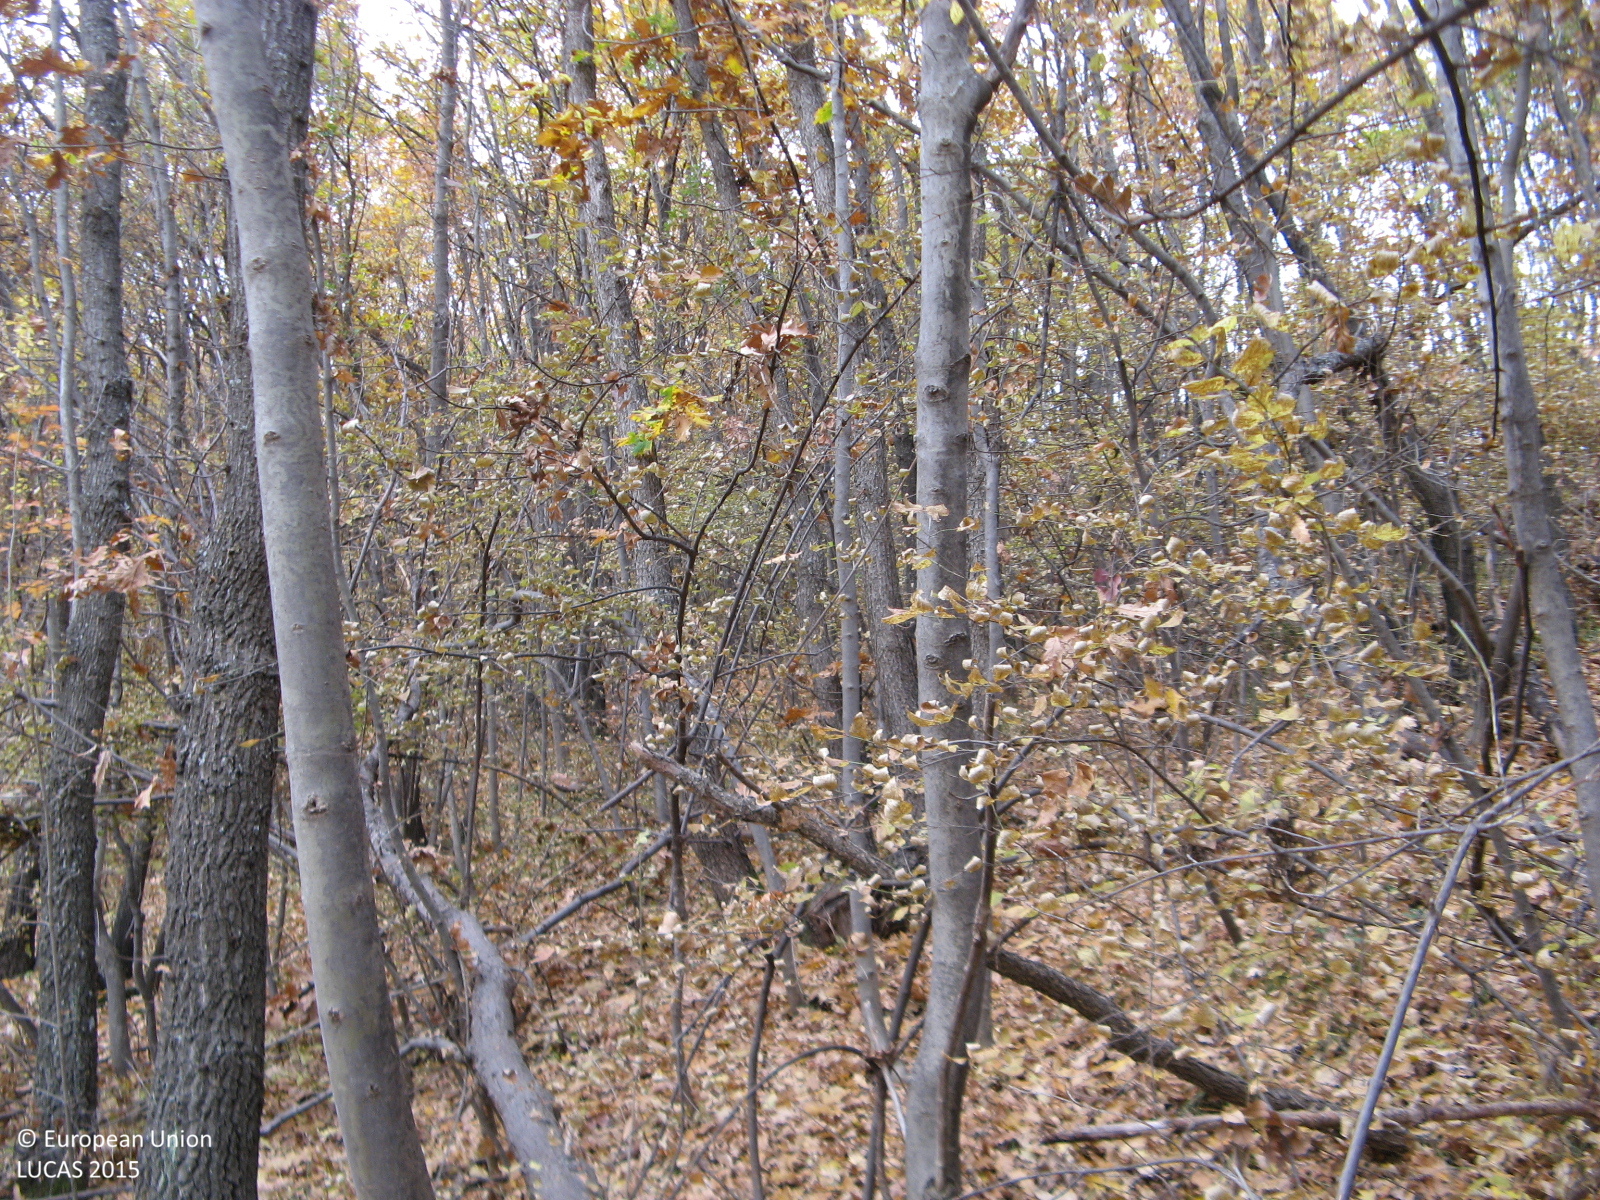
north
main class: Woodland
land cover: Broadleaved woodland
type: mesophytic deciduous forest
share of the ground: > 75 %
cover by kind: broadleaved forest trees 95 %, unconsolidated bare surface 5 %
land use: Forestry
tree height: > 5 m
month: November
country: BG
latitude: 41.7258
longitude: 25.9745
